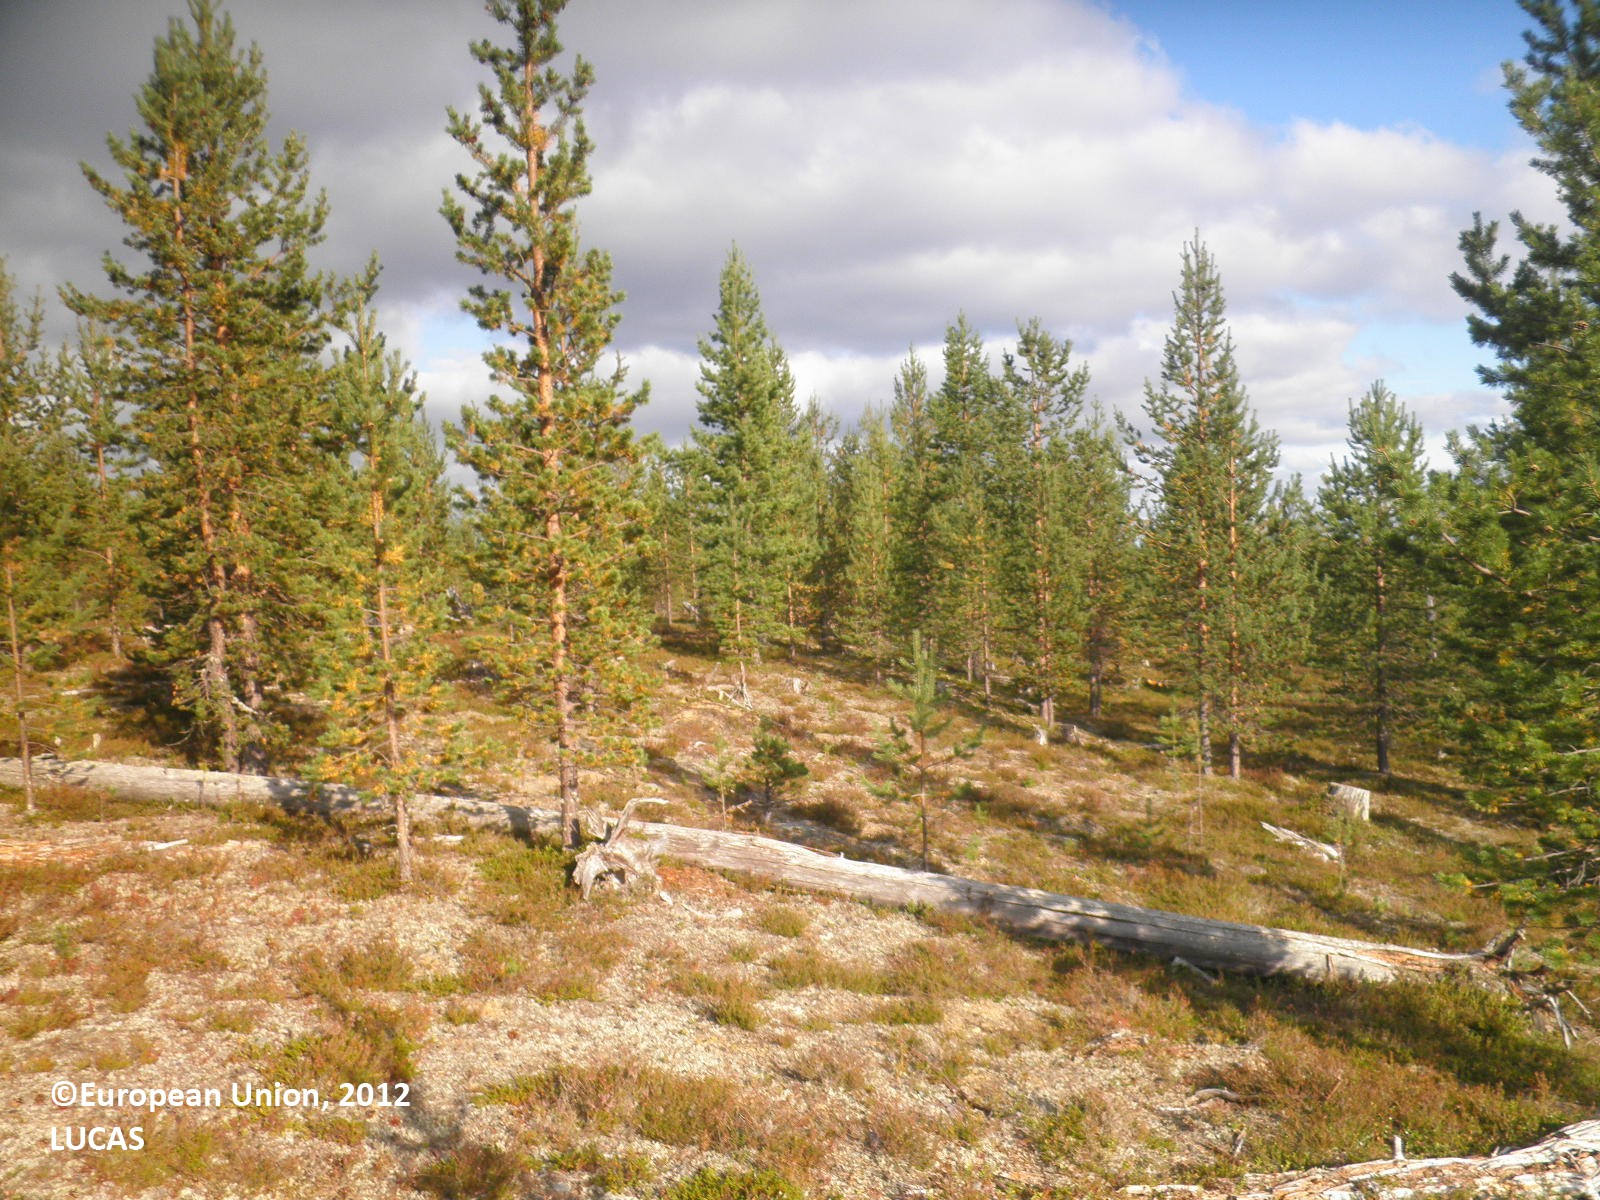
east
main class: Woodland
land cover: Pine dominated coniferous woodland
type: boreal forest
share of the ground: 10 - 25 %
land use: Forestry
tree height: > 5 m
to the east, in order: Pine dominated coniferous woodland; Broadleaved woodland
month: August
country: FI
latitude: 67.9008
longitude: 29.0274
